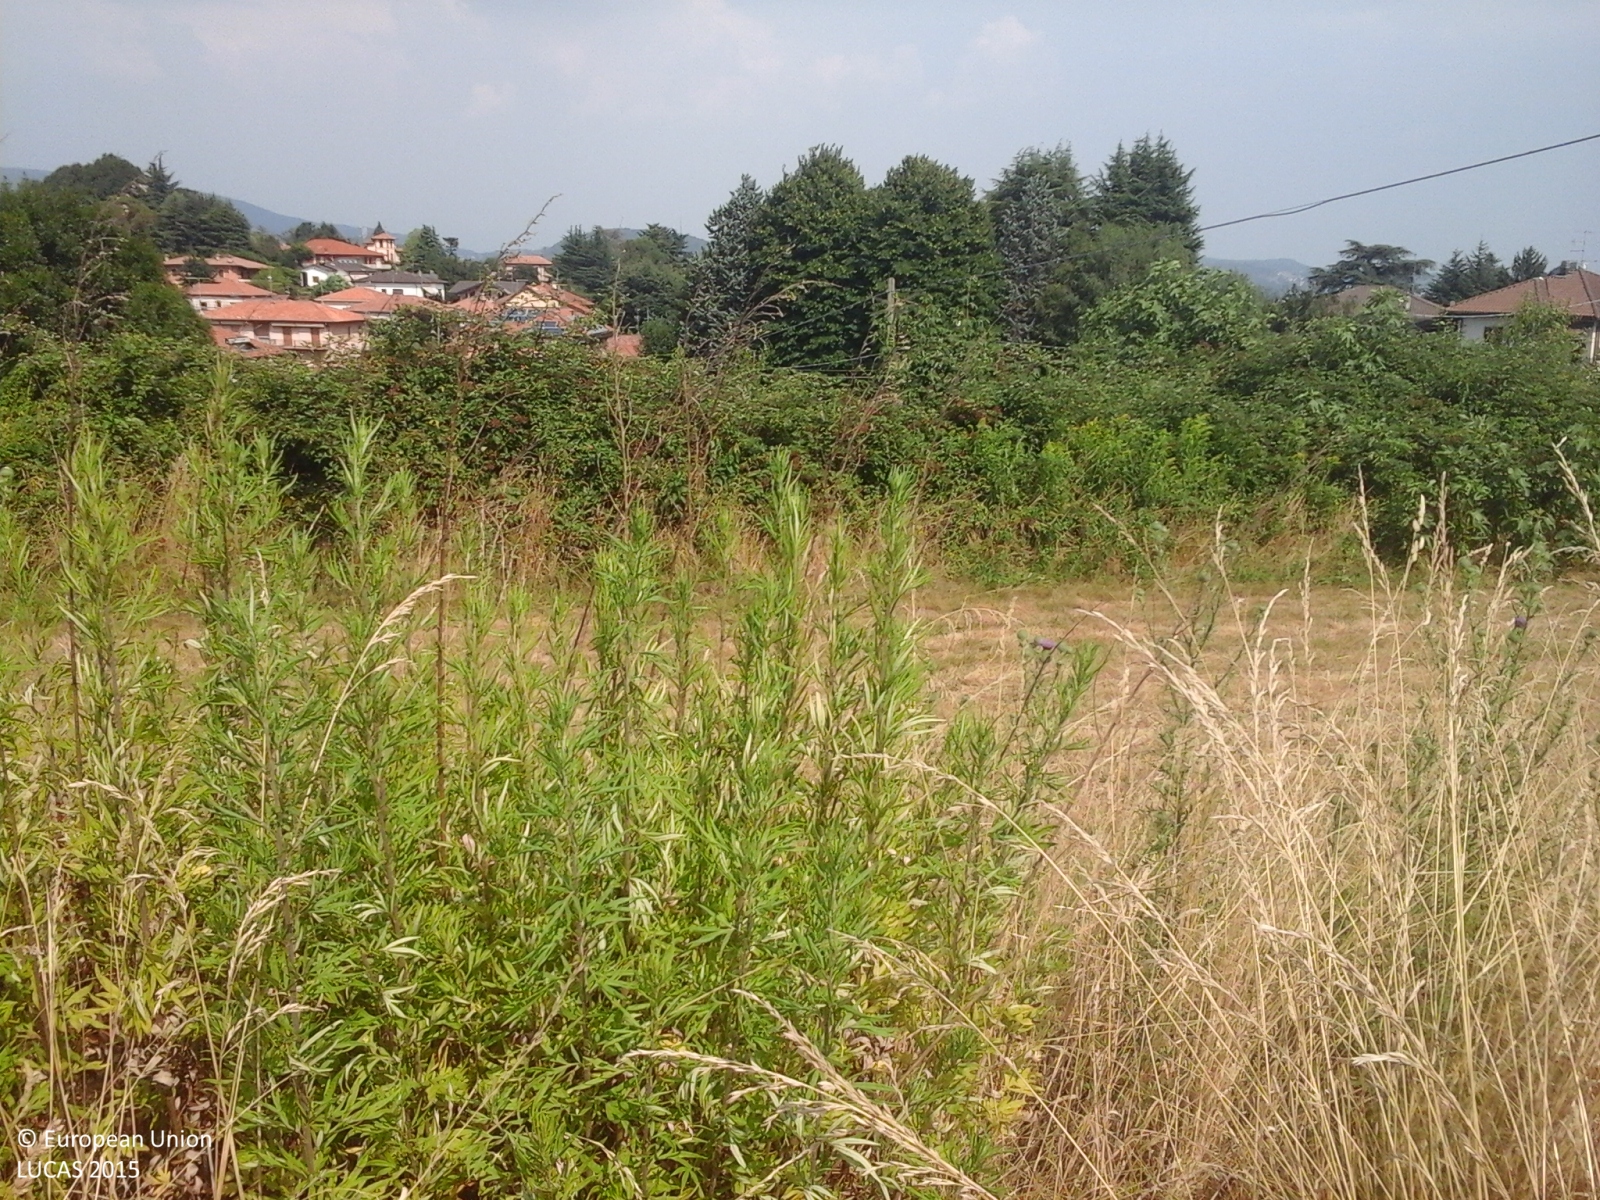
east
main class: Grassland
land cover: Spontaneously vegetated surfaces
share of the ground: > 75 %
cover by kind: herbaceous plants 100 %
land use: Semi-natural and natural areas not in use
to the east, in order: Spontaneously vegetated surfaces; Abandoned hedges; Shrubland with sparse tree cover; Abandoned hedges; Grassland without tree/shrub cover; Abandoned hedges; Electric lines; Grassland without tree/shrub cover; Electric lines; Grassland without tree/shrub cover; Artificial constructions in urban areas
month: July
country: IT
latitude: 45.7884
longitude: 9.0367
